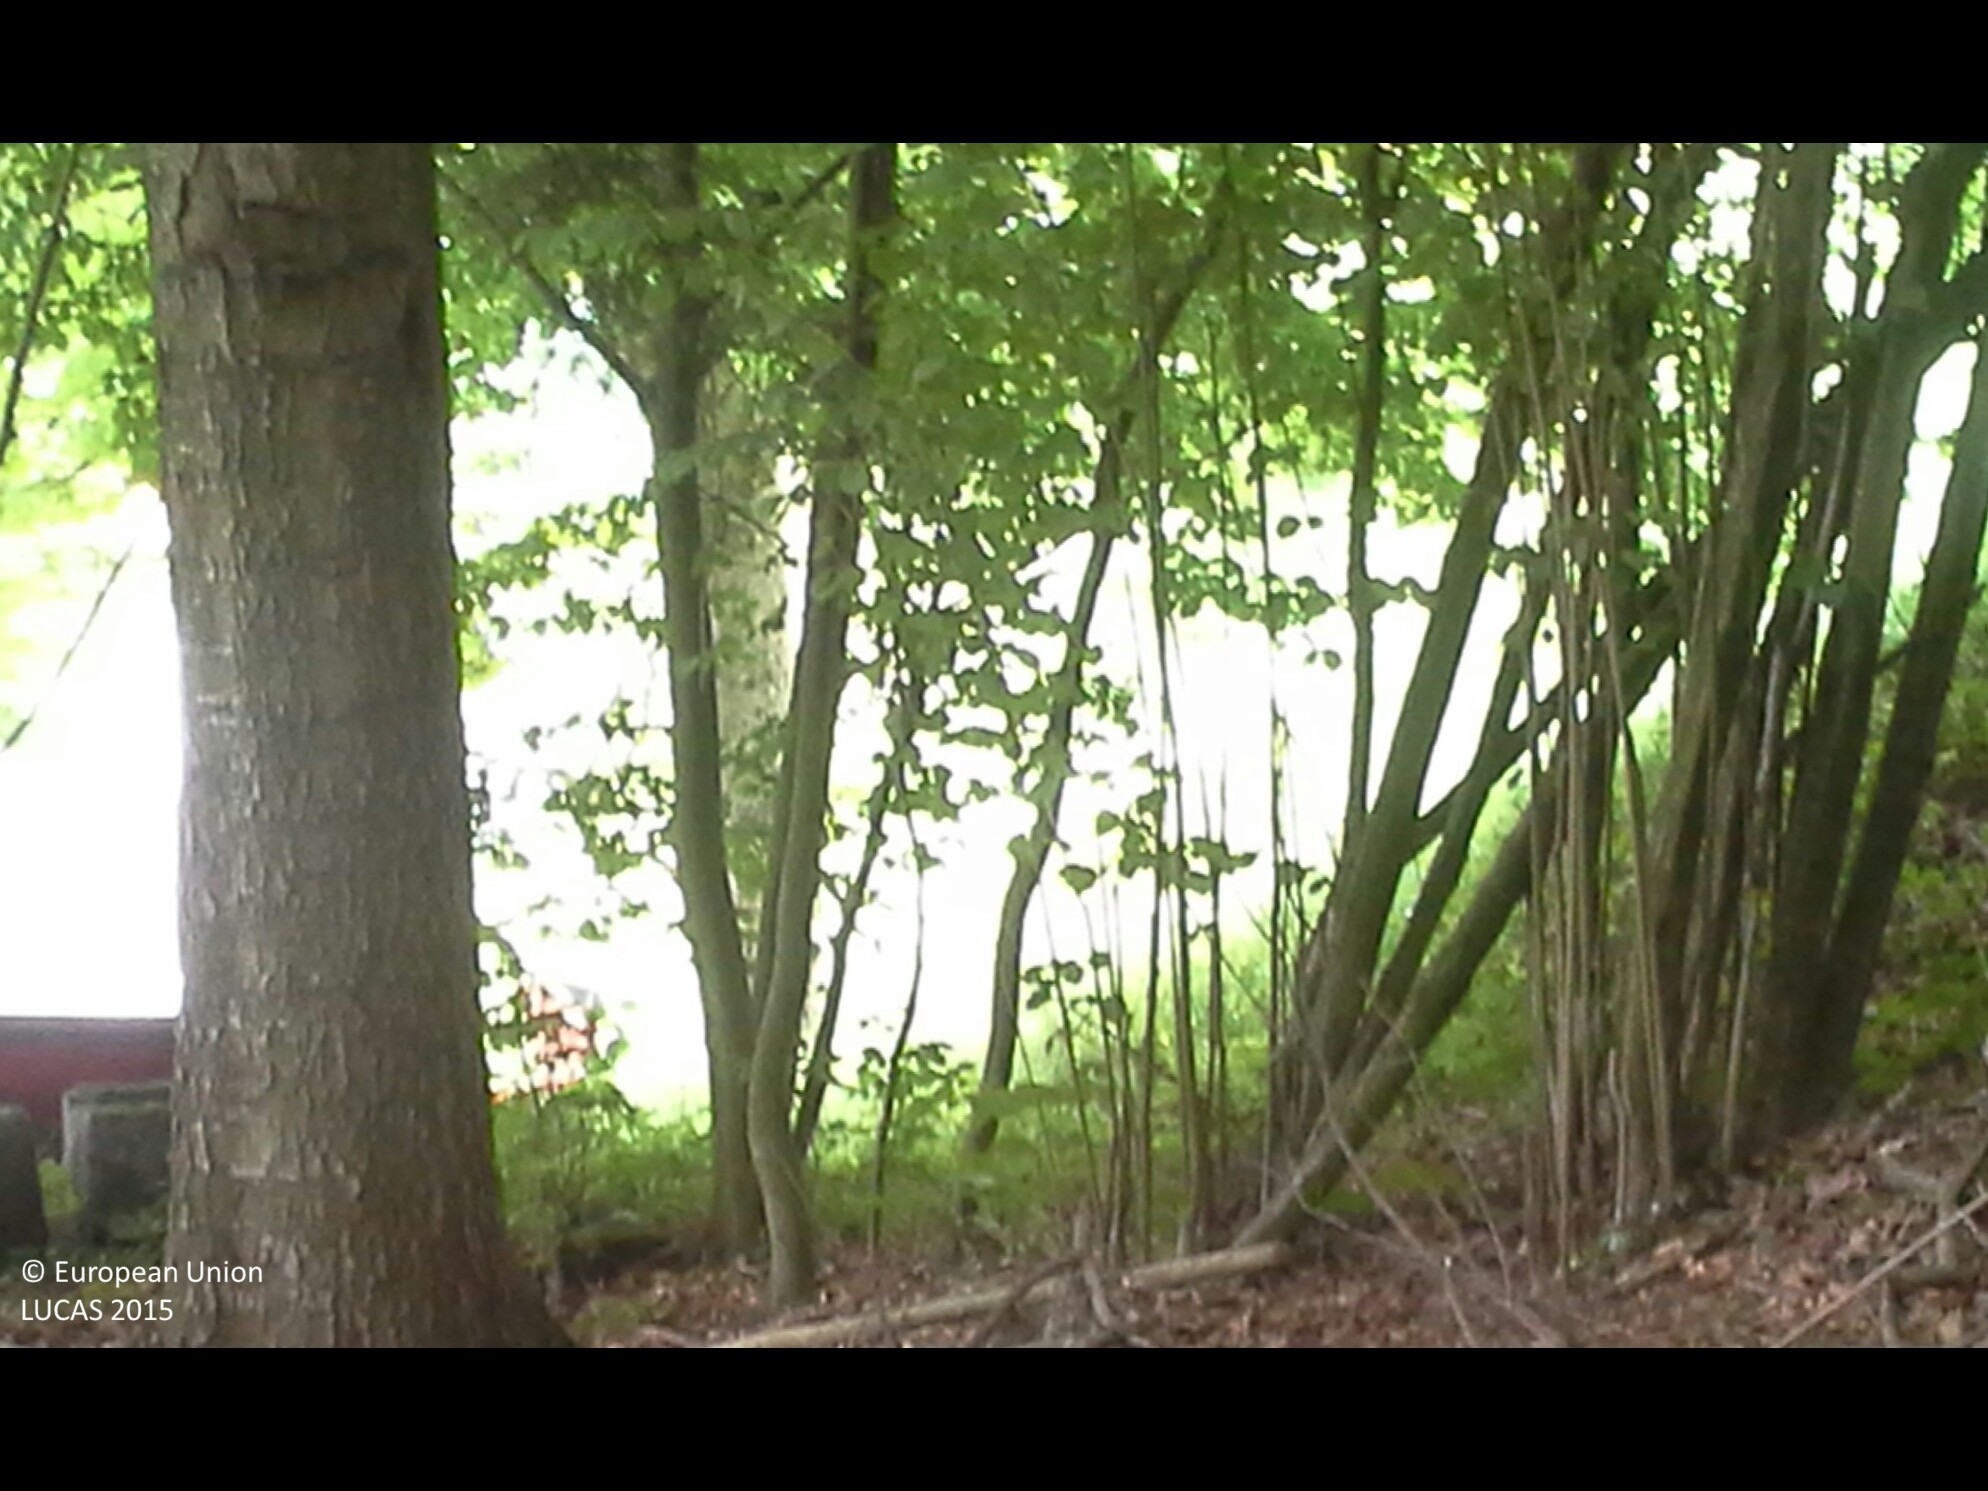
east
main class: Woodland
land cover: Broadleaved woodland
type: mesophytic deciduous forest
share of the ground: > 75 %
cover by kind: broadleaved forest trees 100 %
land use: Forestry
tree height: > 5 m
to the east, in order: Broadleaved woodland; Rivers and streams; Broadleaved woodland; Grassland with sparse tree/shrub cover; Artificial constructions in urban areas; Grassland with sparse tree/shrub cover; Electric lines; Grassland with sparse tree/shrub cover; Fences; Broadleaved woodland; Inland fresh running water; Paved roads, cycling and walking lanes; Fences; Grassland without tree/shrub cover; Fences; Spruce dominated coniferous woodland
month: June
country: AT
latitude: 48.0059
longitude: 14.4904
